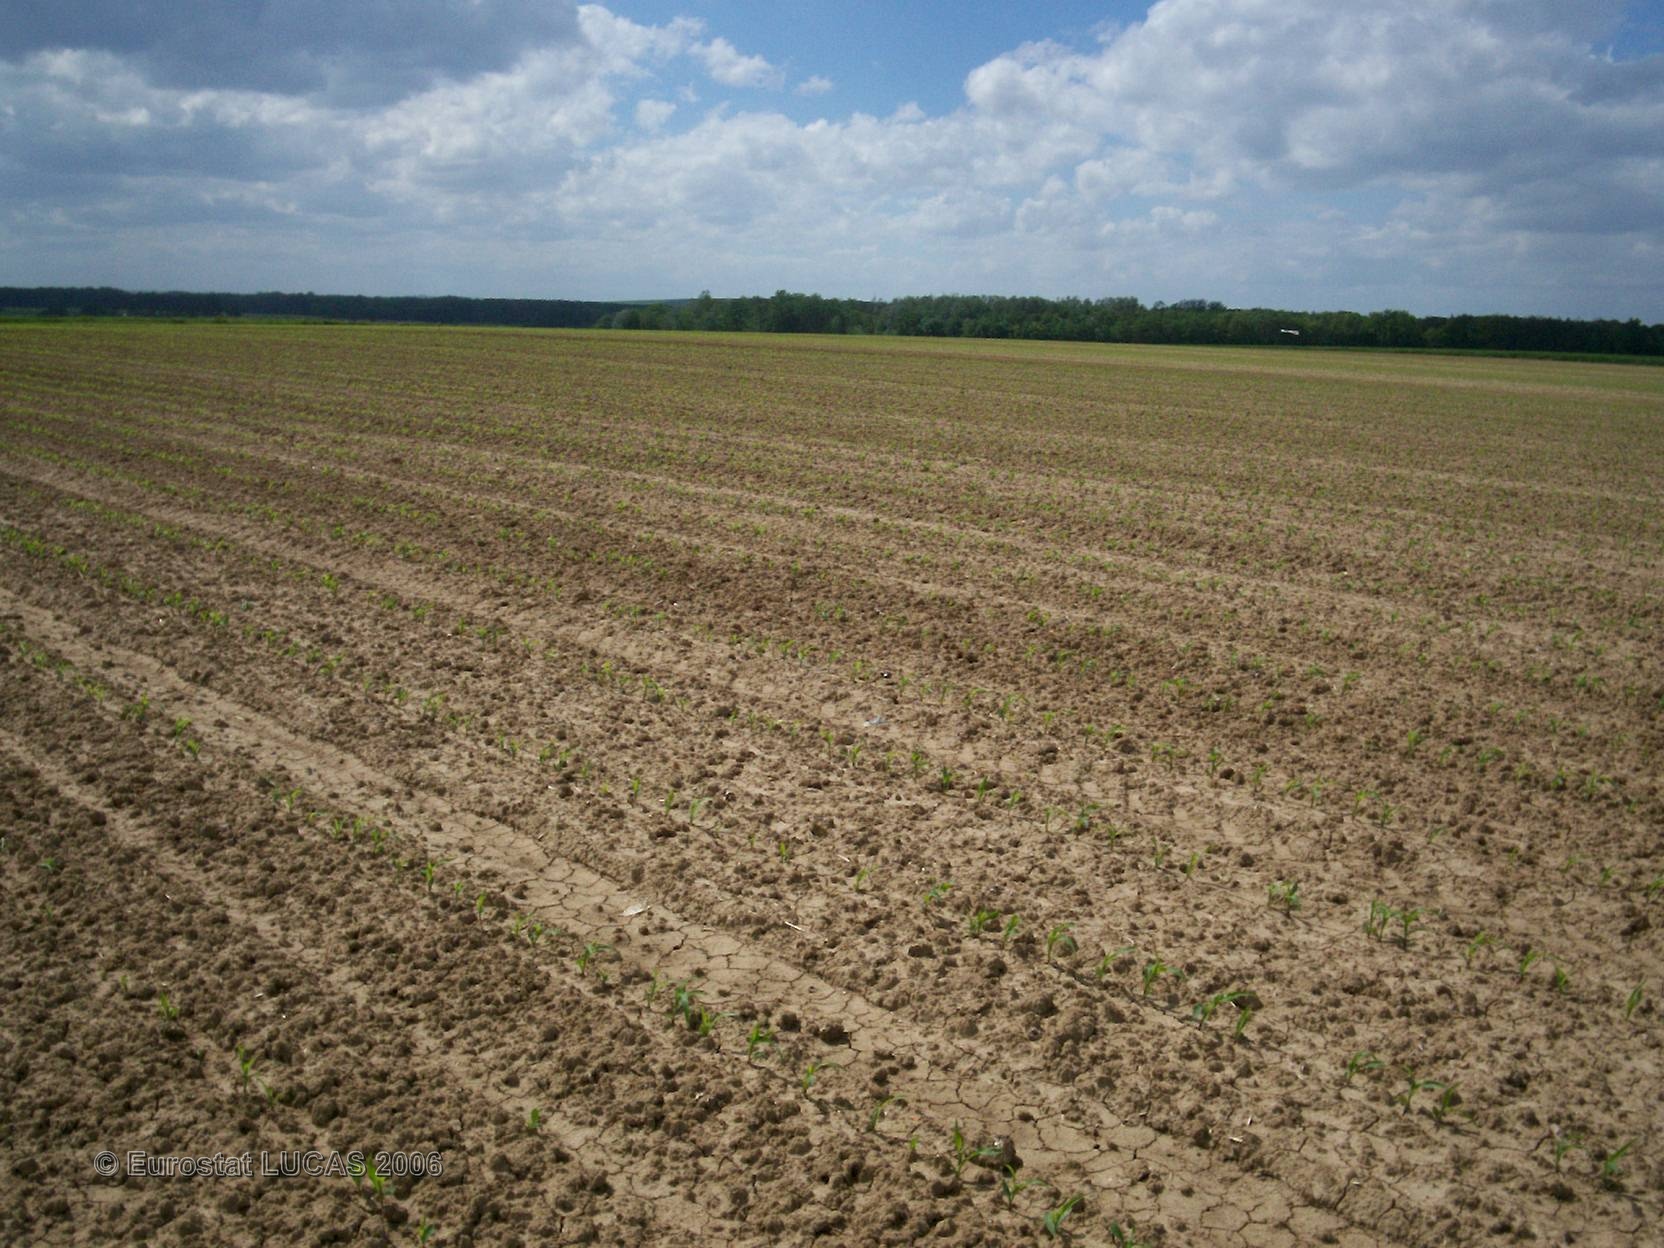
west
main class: Cropland
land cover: Maize
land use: Agriculture (excluding fallow land and kitchen gardens)
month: May
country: FR
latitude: 48.3723
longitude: 4.4489
